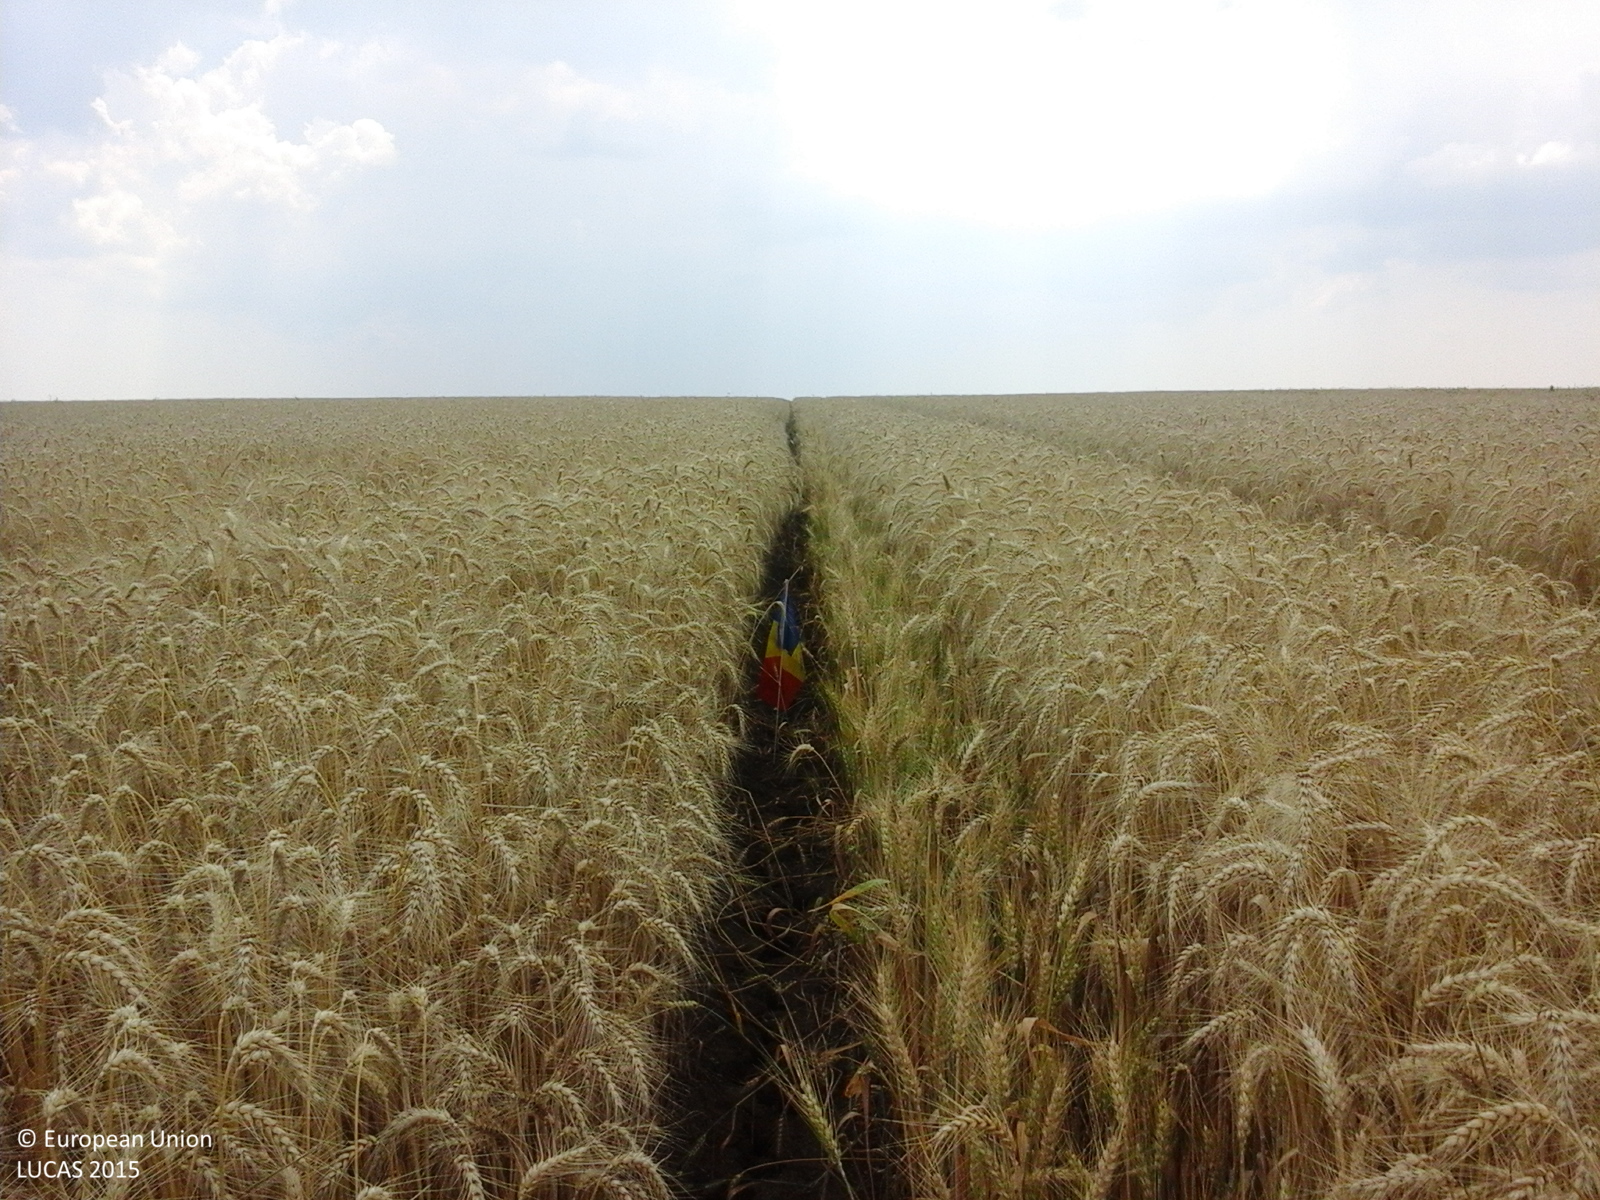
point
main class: Cropland
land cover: Common wheat
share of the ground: > 75 %
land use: Agriculture (excluding fallow land and kitchen gardens)
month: July
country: RO
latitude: 43.9427
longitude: 25.1669
